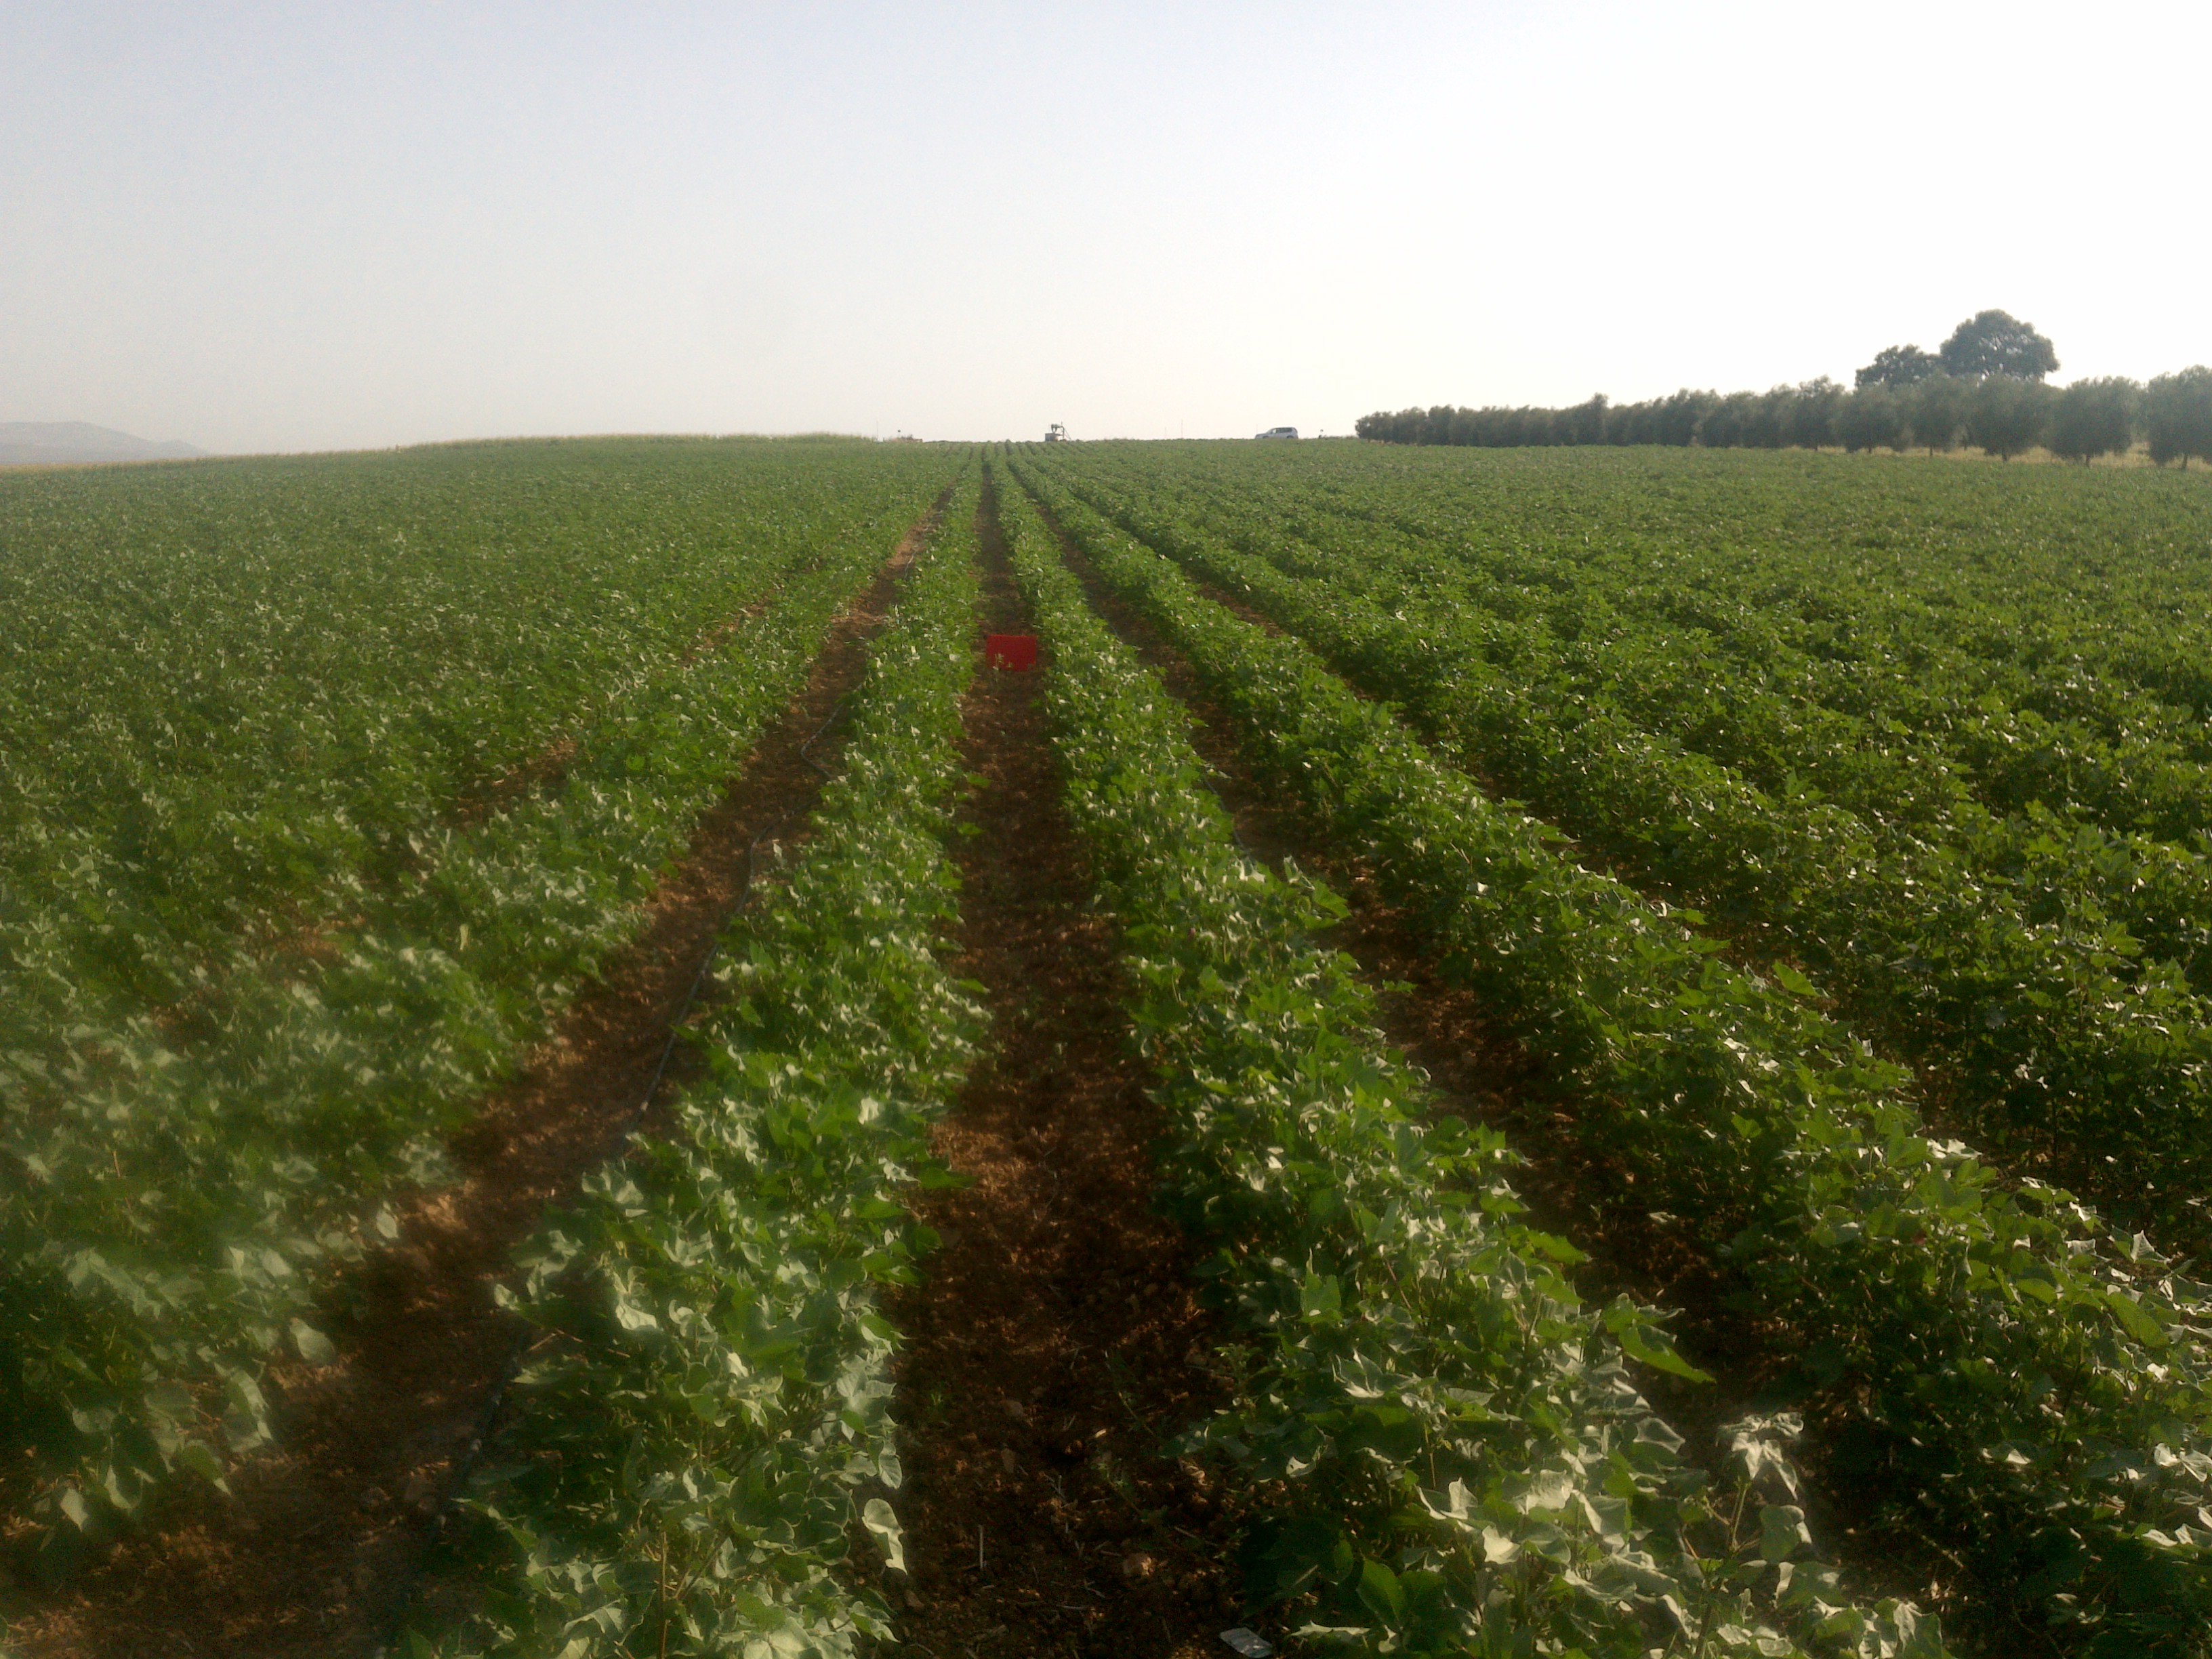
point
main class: Cropland
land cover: Cotton
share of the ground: 50 - 75 %
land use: Agriculture (excluding fallow land and kitchen gardens)
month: July
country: ES
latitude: 37.4397
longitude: -4.8478
